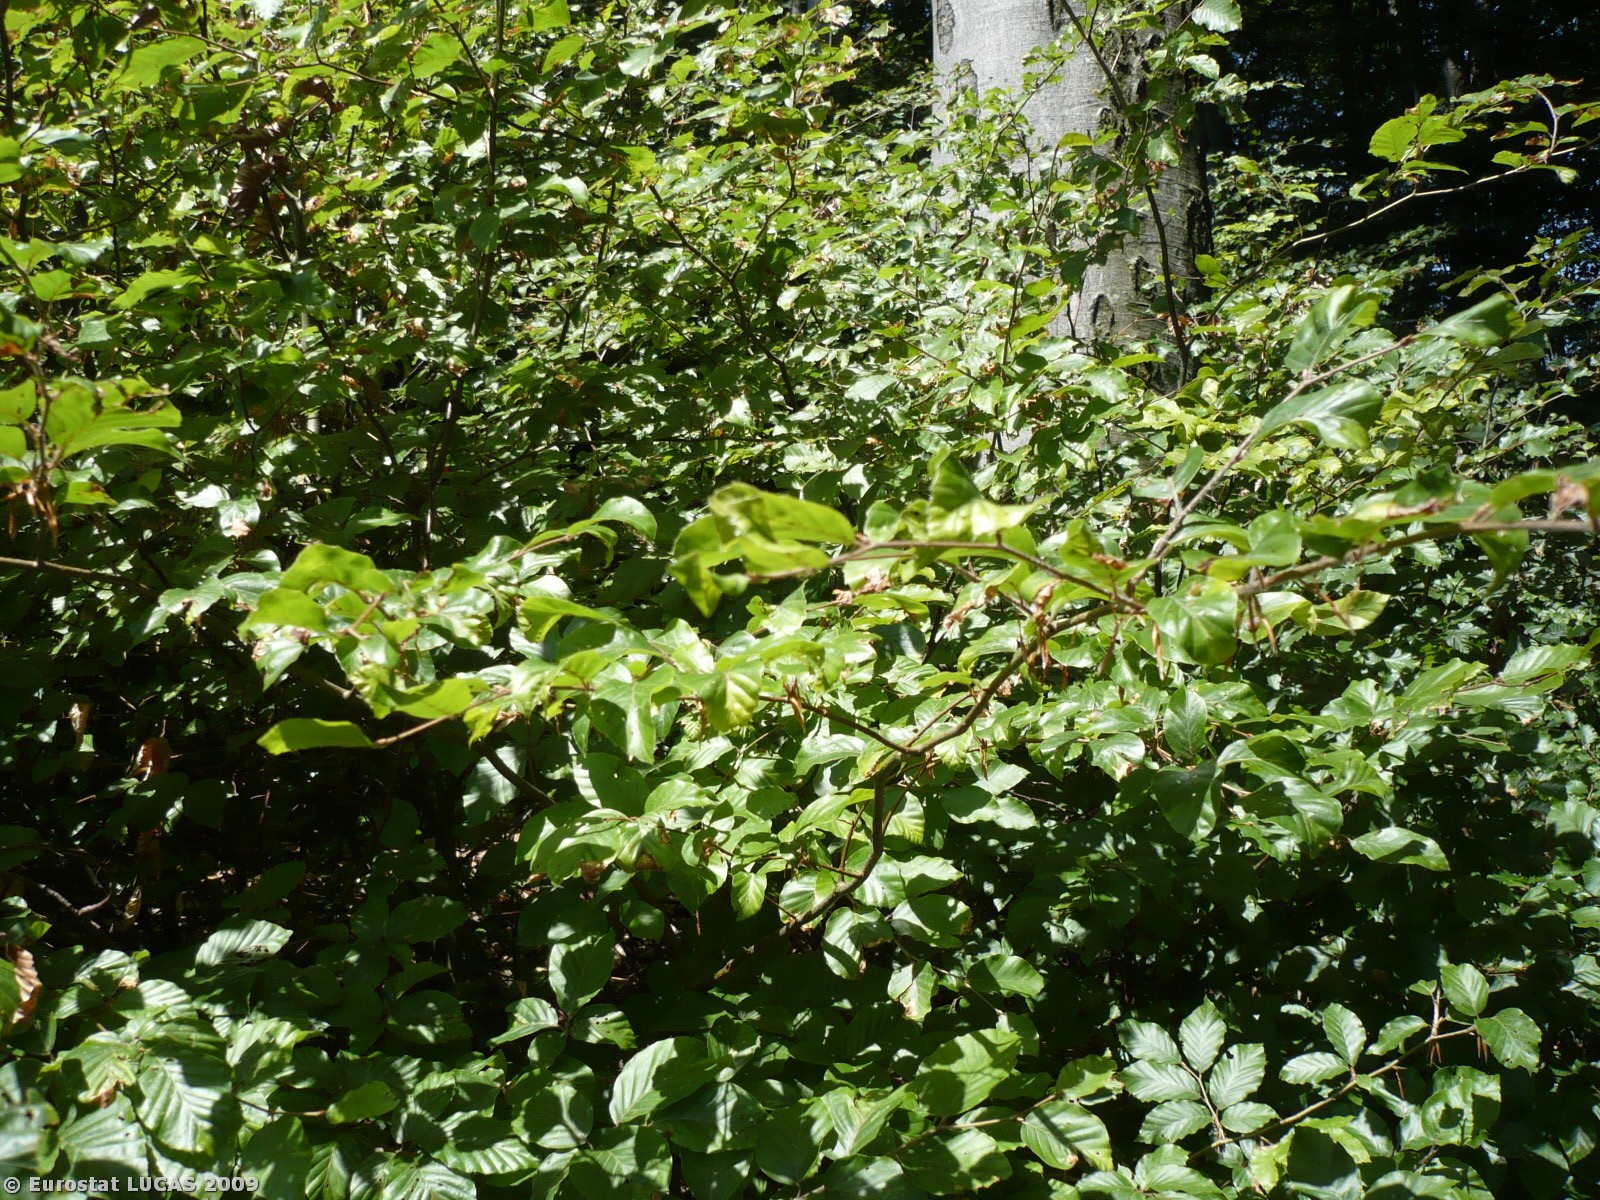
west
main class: Woodland
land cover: Broadleaved woodland
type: beech forest
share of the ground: > 75 %
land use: Forestry
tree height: > 5 m
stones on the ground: < 10 %
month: June
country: SI
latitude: 45.9825
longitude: 15.3542
